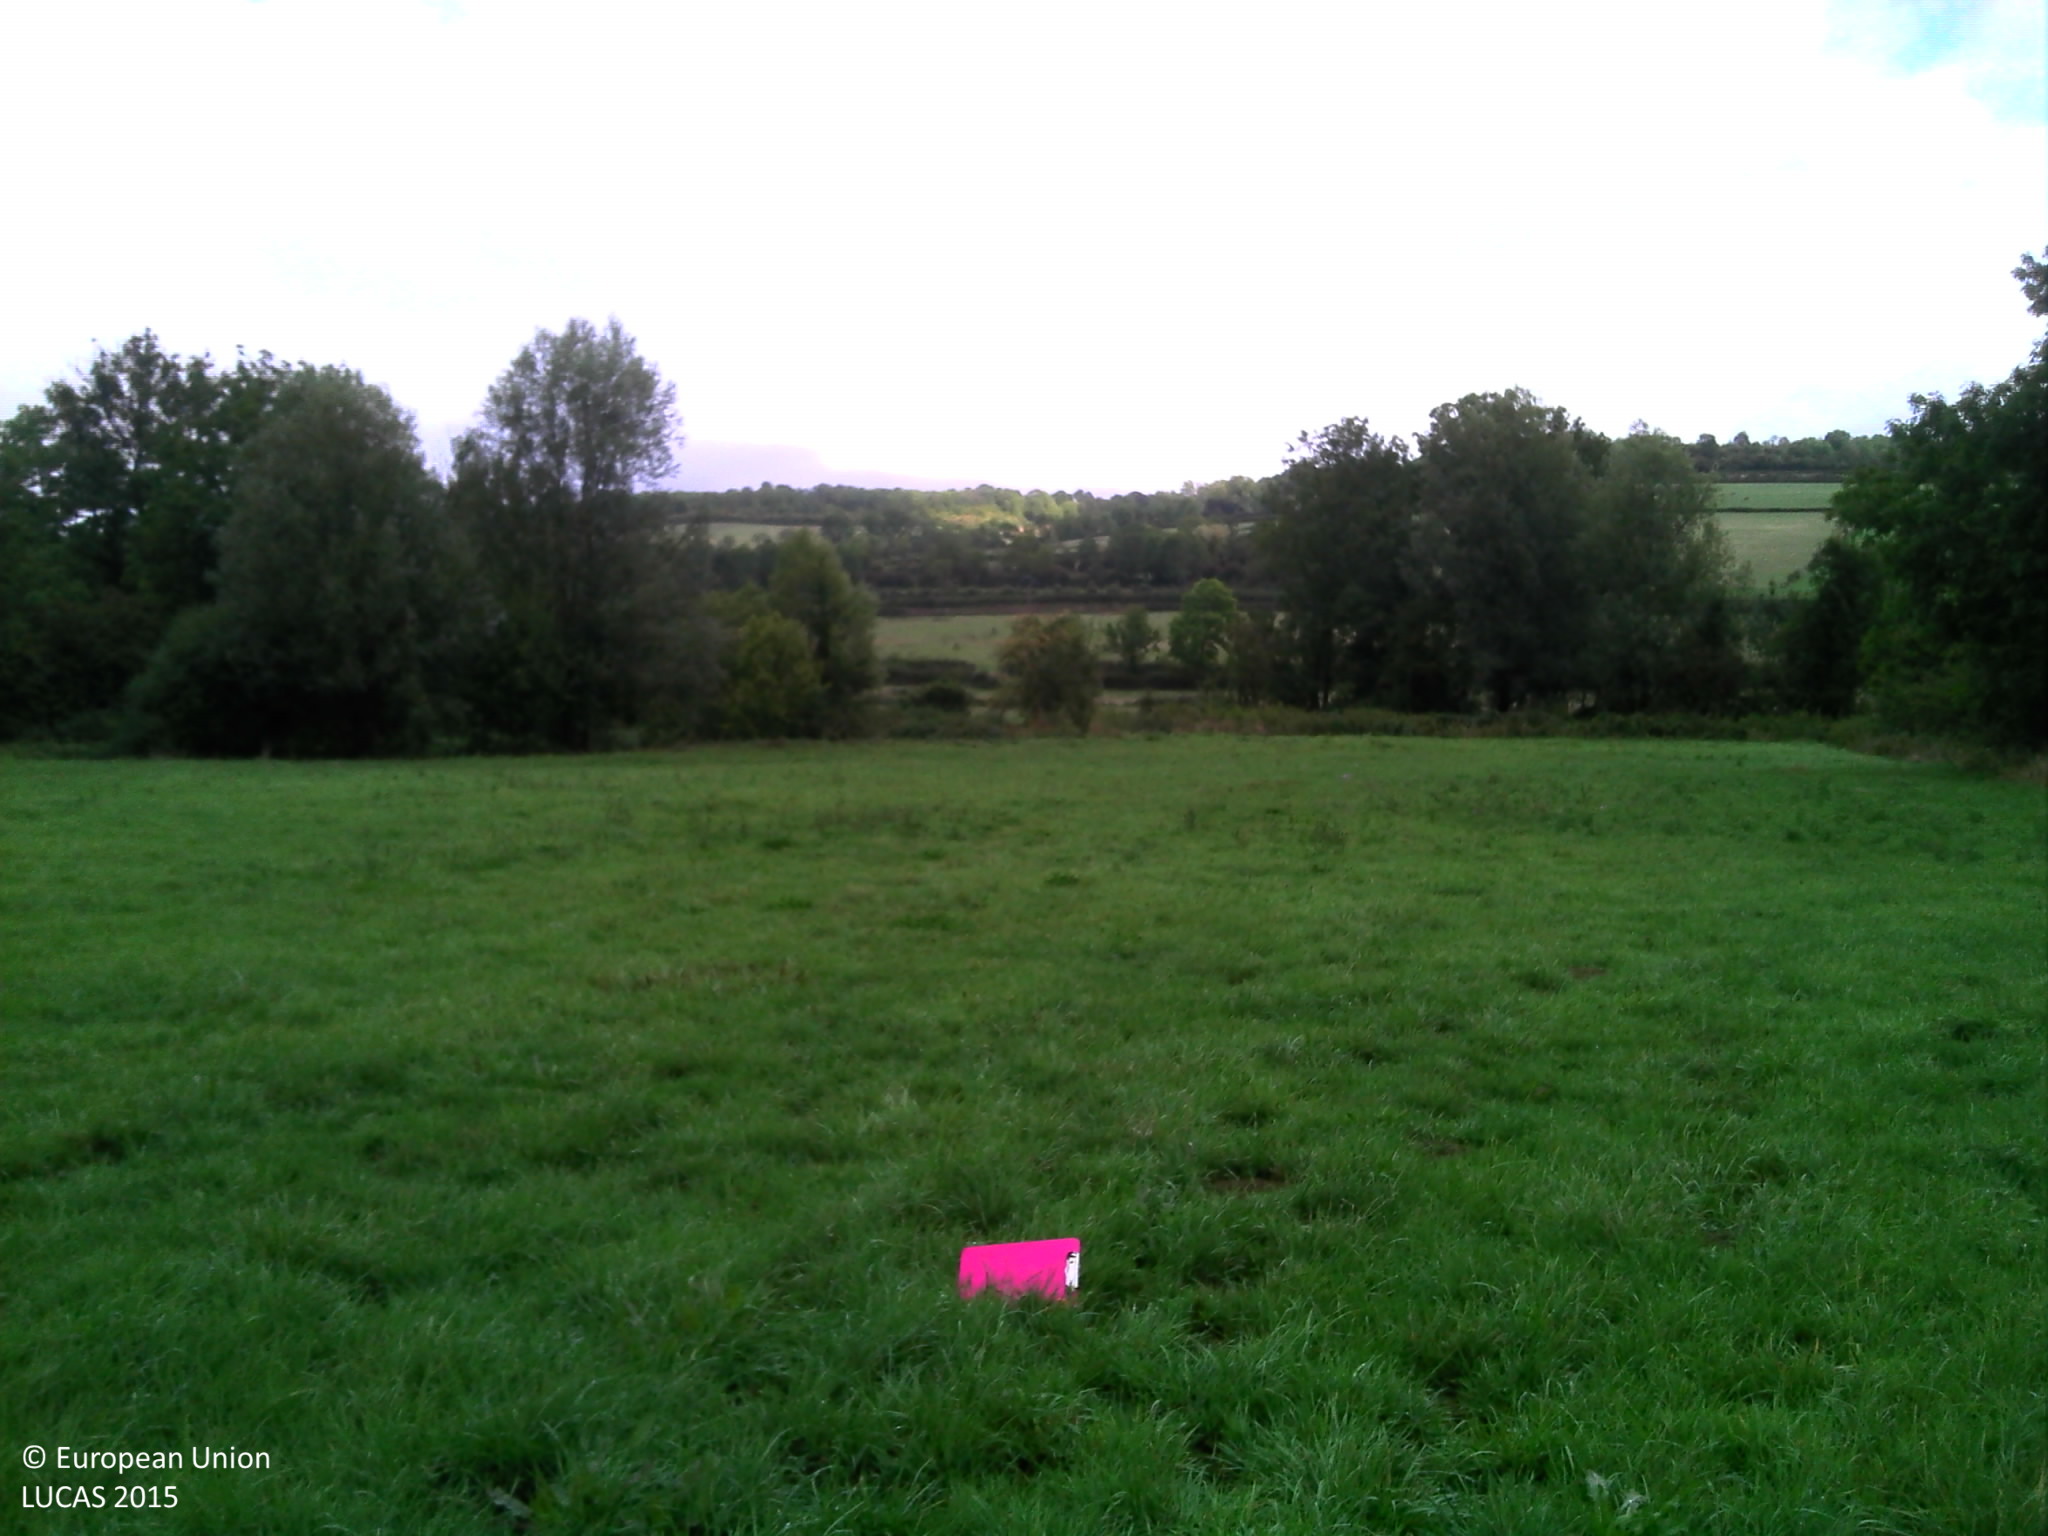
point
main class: Grassland
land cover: Grassland without tree/shrub cover
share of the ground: > 75 %
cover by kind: herbaceous plants 100 %
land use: Agriculture (excluding fallow land and kitchen gardens)
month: September
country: FR
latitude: 47.2339
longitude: 4.4121
